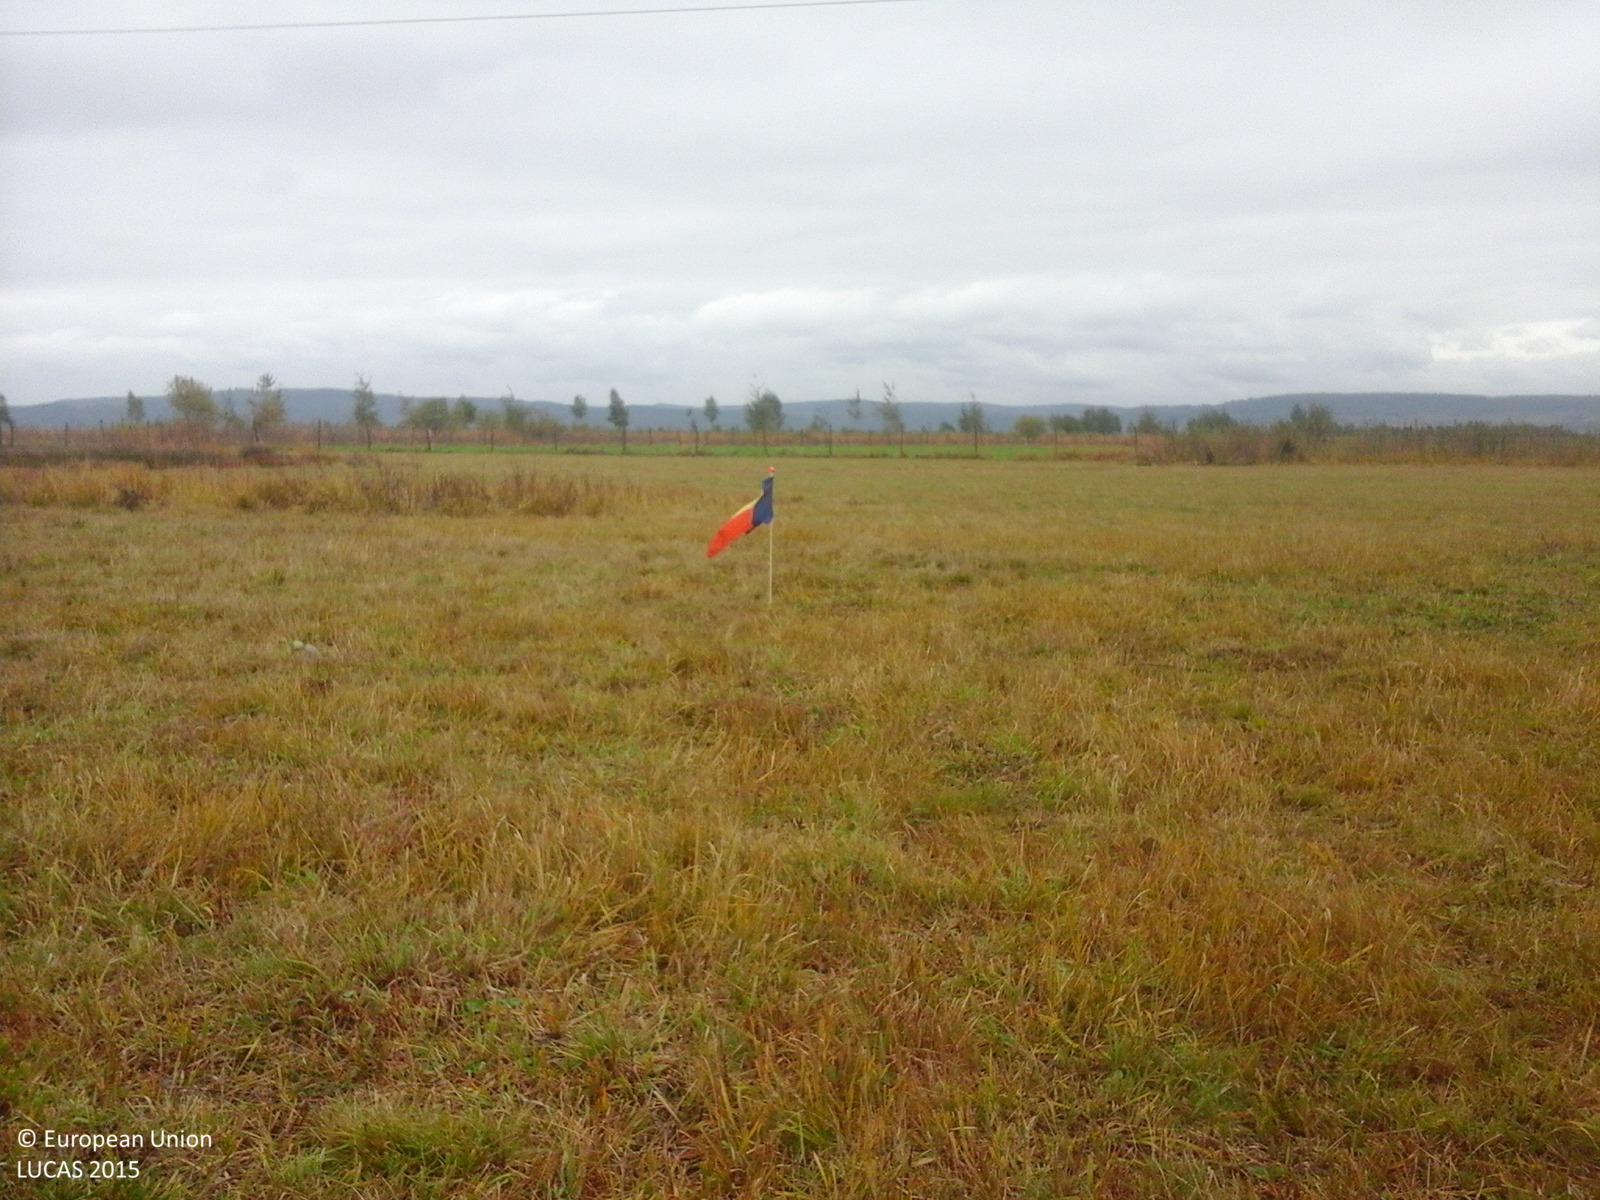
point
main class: Grassland
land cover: Grassland without tree/shrub cover
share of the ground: > 75 %
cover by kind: herbaceous plants 100 %
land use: Agriculture (excluding fallow land and kitchen gardens)
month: October
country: RO
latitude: 45.7459
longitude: 24.5951
